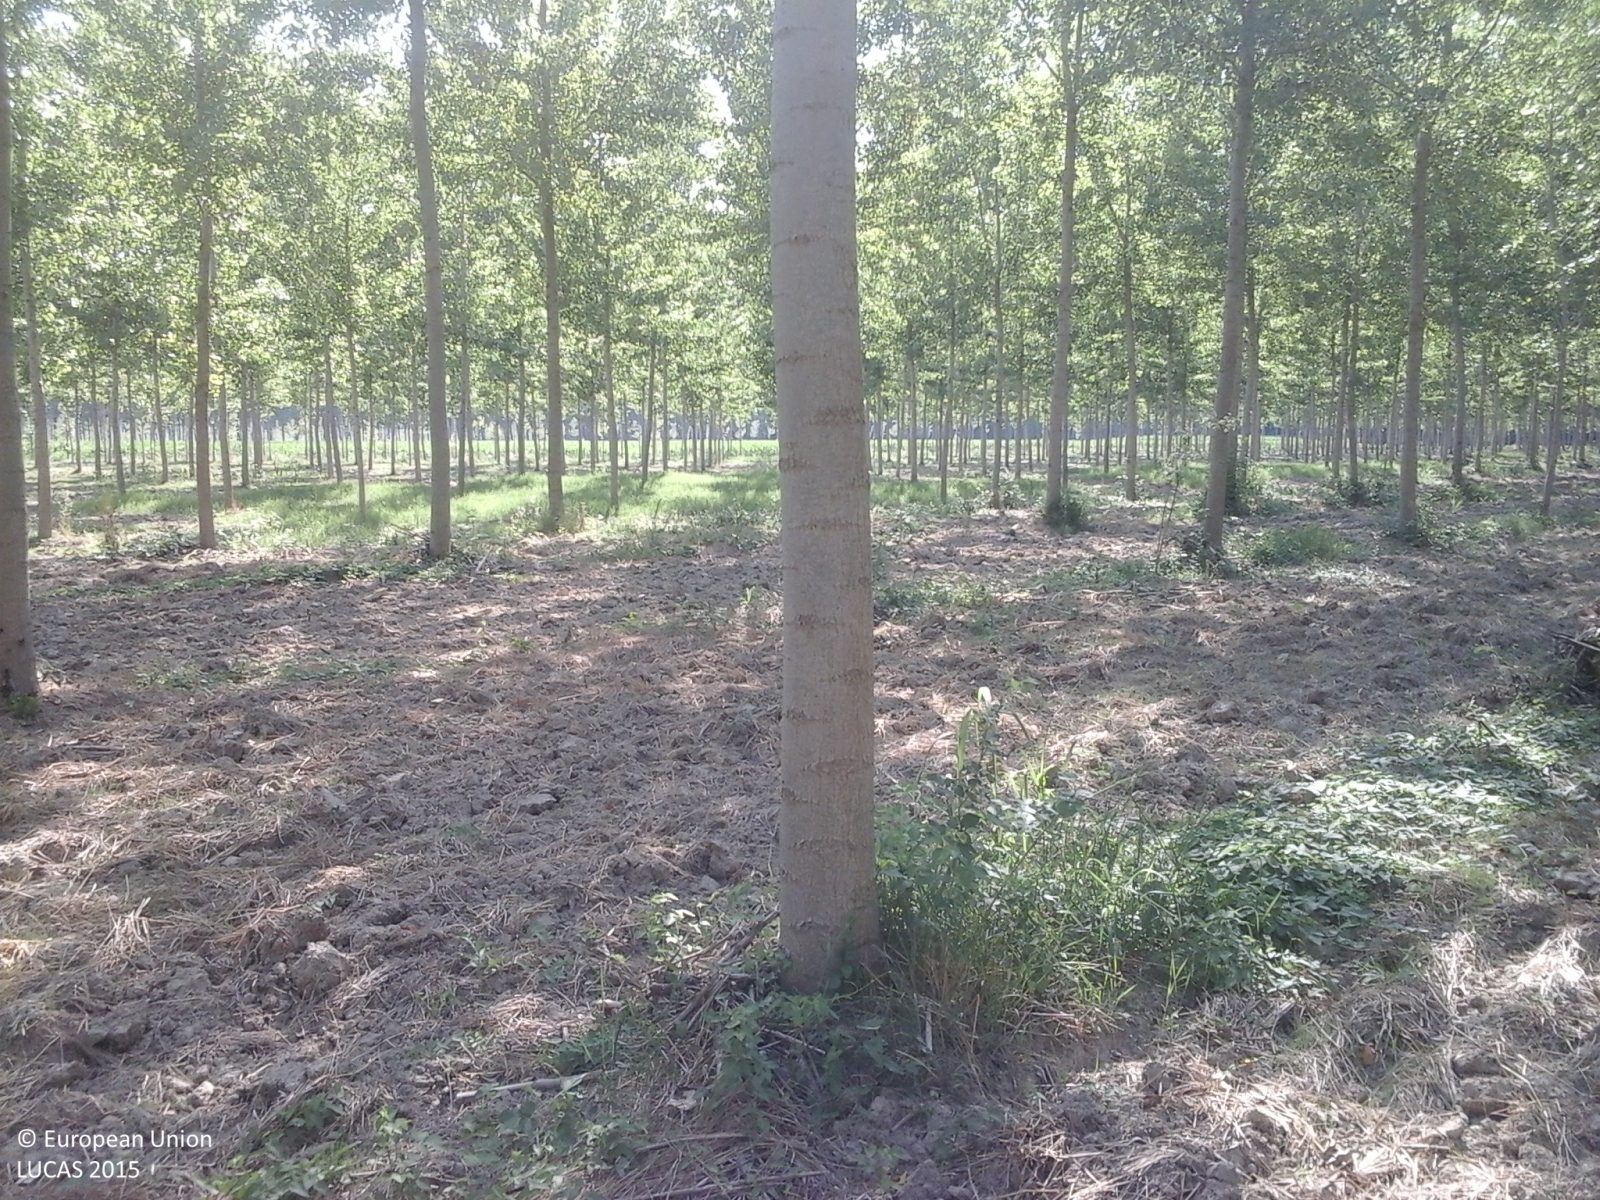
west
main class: Woodland
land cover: Broadleaved woodland
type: non-riverine alder, birch or aspen forest
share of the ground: > 75 %
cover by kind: broadleaved forest trees 85 %, unconsolidated bare surface 15 %
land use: Forestry
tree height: > 5 m
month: June
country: IT
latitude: 44.9739
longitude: 8.7218
